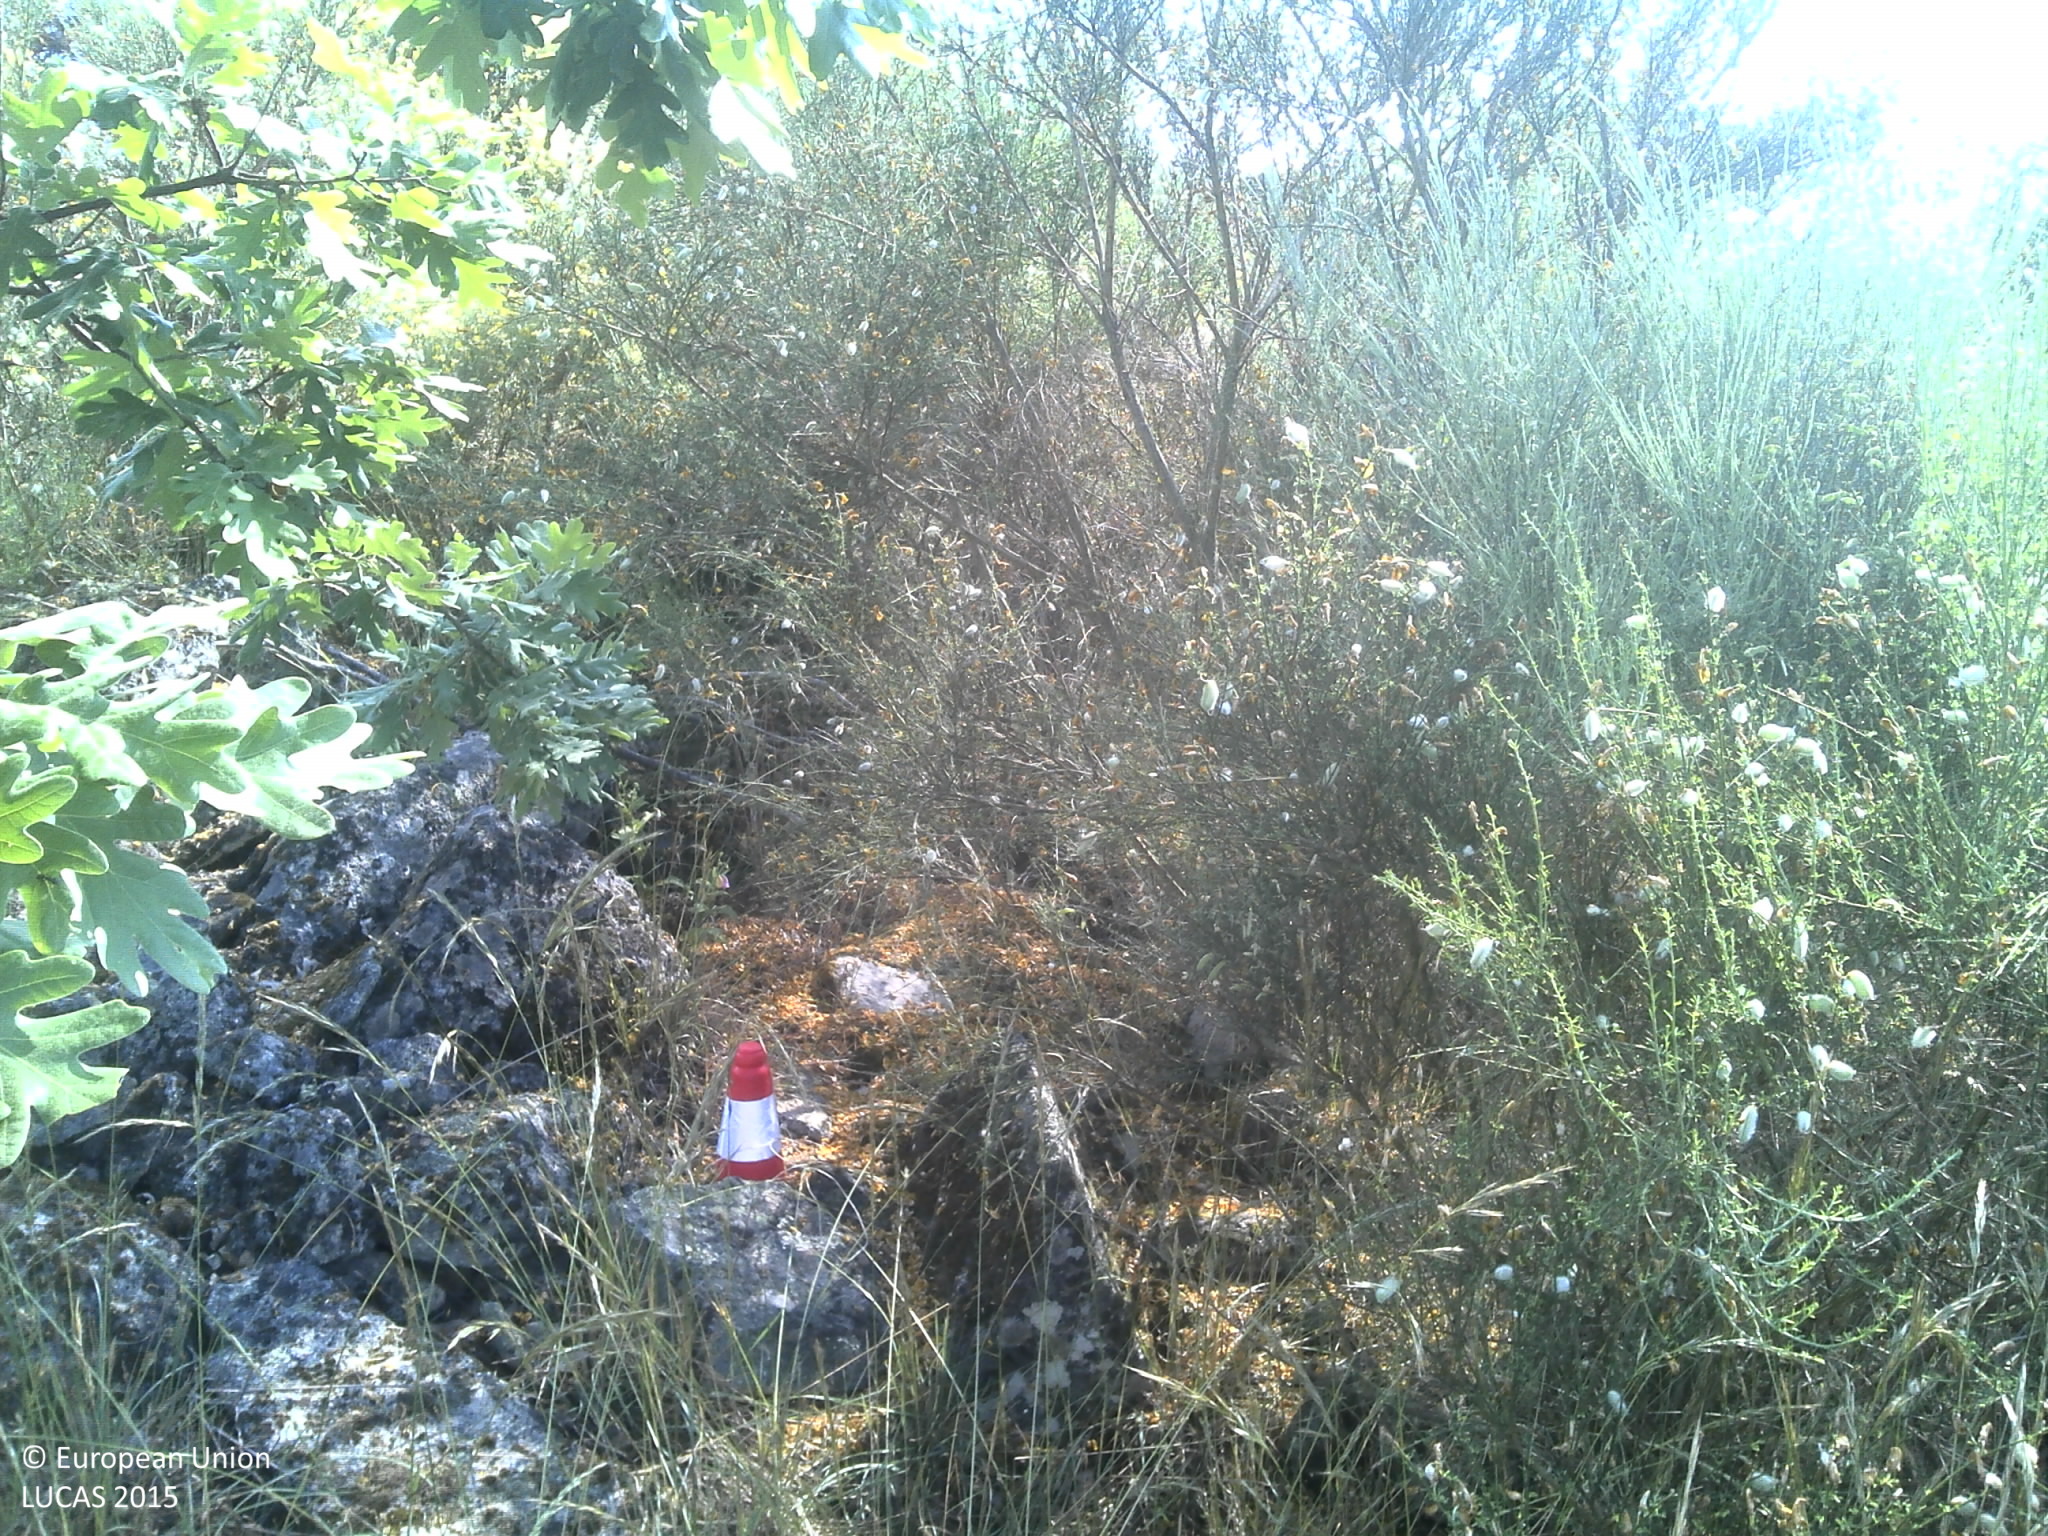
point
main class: Shrubland
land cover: Shrubland with sparse tree cover
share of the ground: 50 - 75 %
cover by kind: shrubs 75 %, unconsolidated bare surface 10 %, broadleaved forest trees 5 %
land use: Abandoned areas
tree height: < 5 m
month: June
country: PT
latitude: 40.5745
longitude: -7.1253
